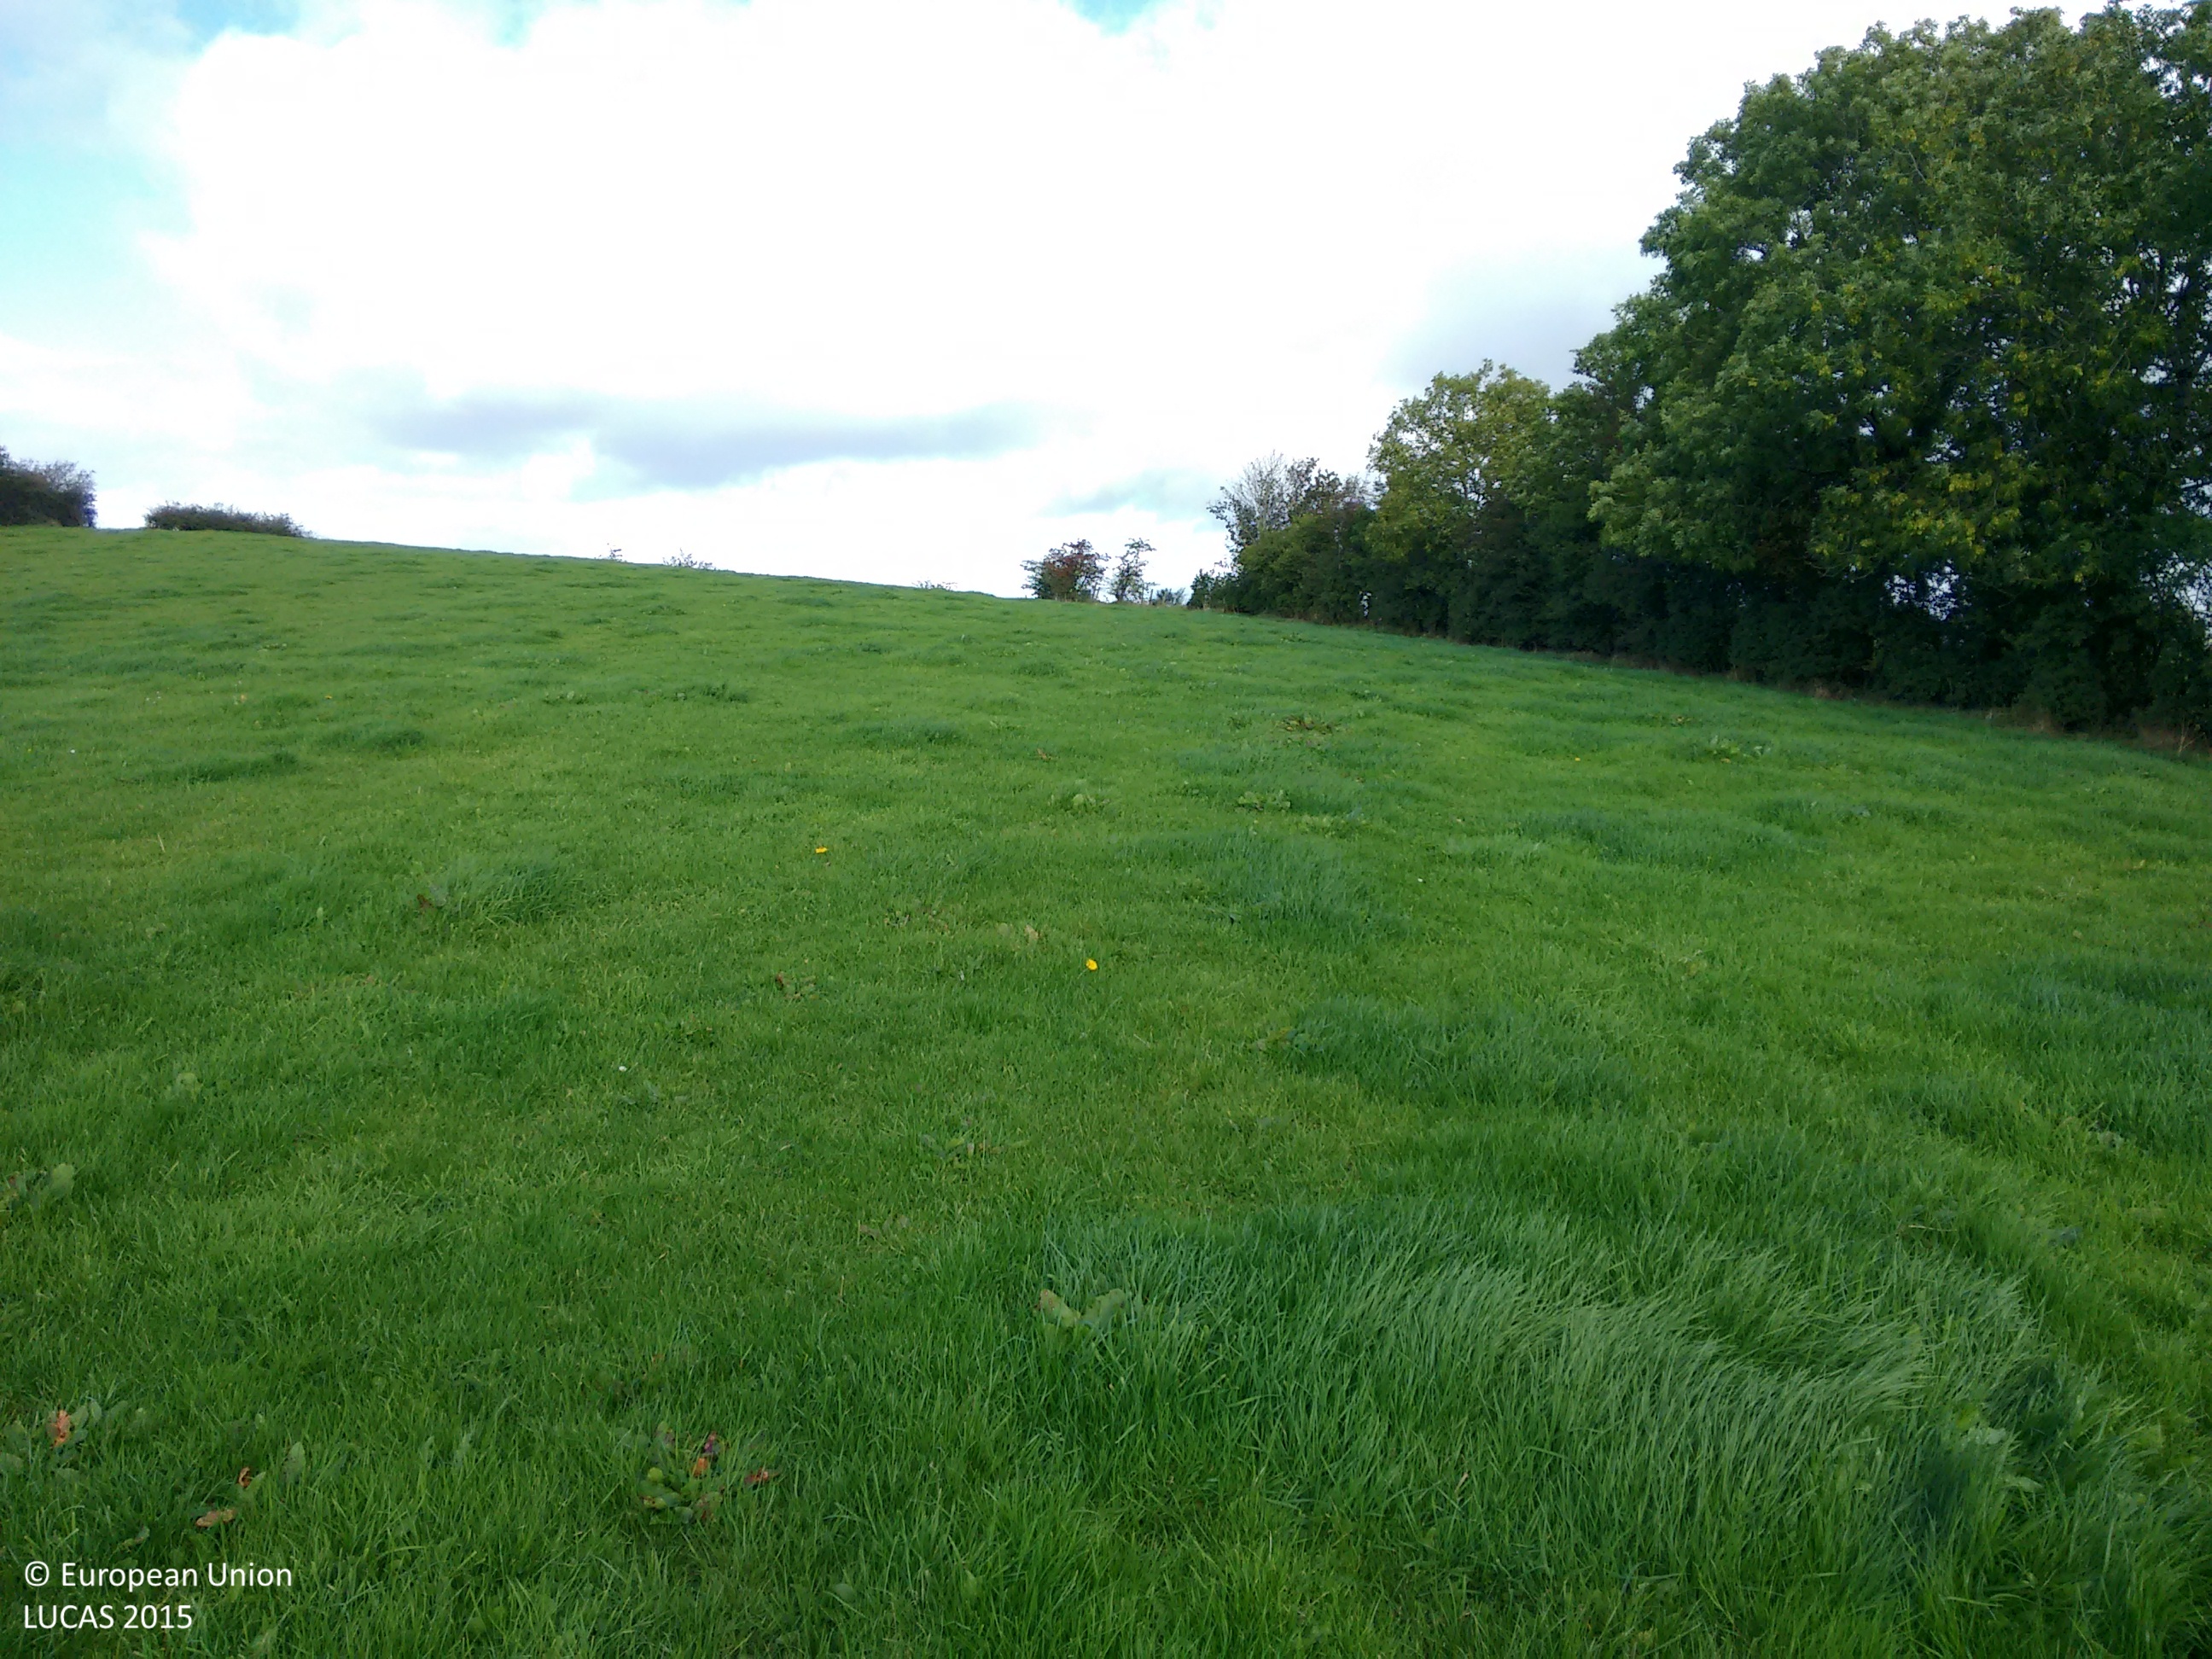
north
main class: Grassland
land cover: Grassland without tree/shrub cover
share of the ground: > 75 %
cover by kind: herbaceous plants 100 %
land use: Agriculture (excluding fallow land and kitchen gardens)
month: September
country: IE
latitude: 54.1854
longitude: -6.7910
